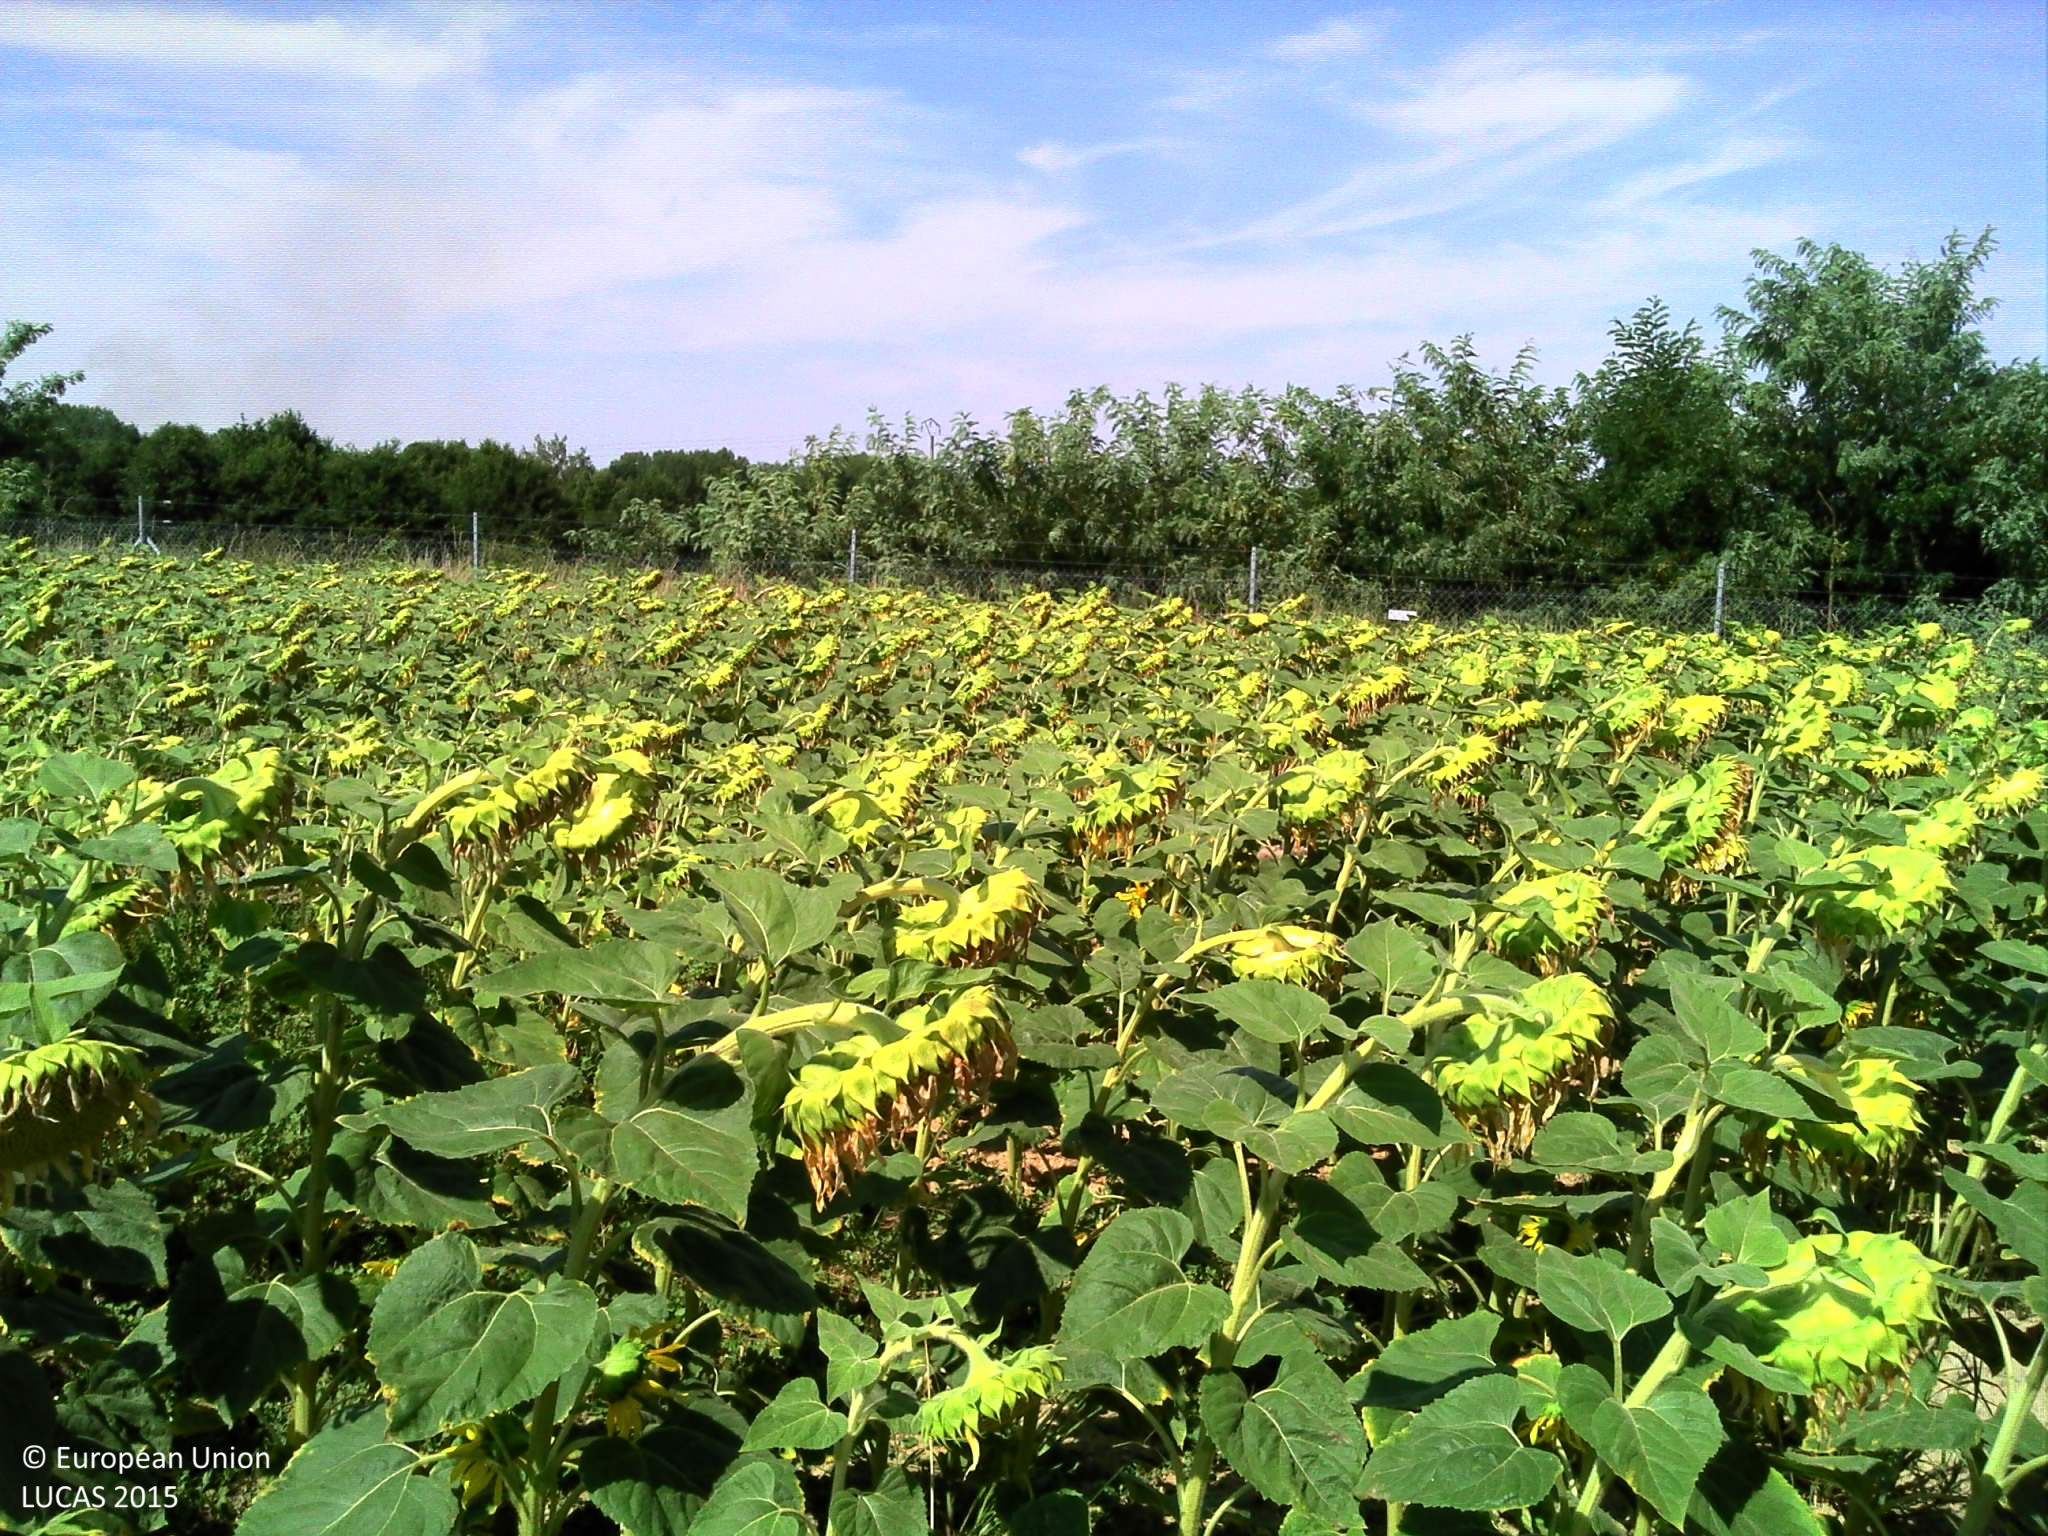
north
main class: Cropland
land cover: Sunflower
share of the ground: > 75 %
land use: Agriculture (excluding fallow land and kitchen gardens)
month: August
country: FR
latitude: 47.8830
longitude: 3.4291
